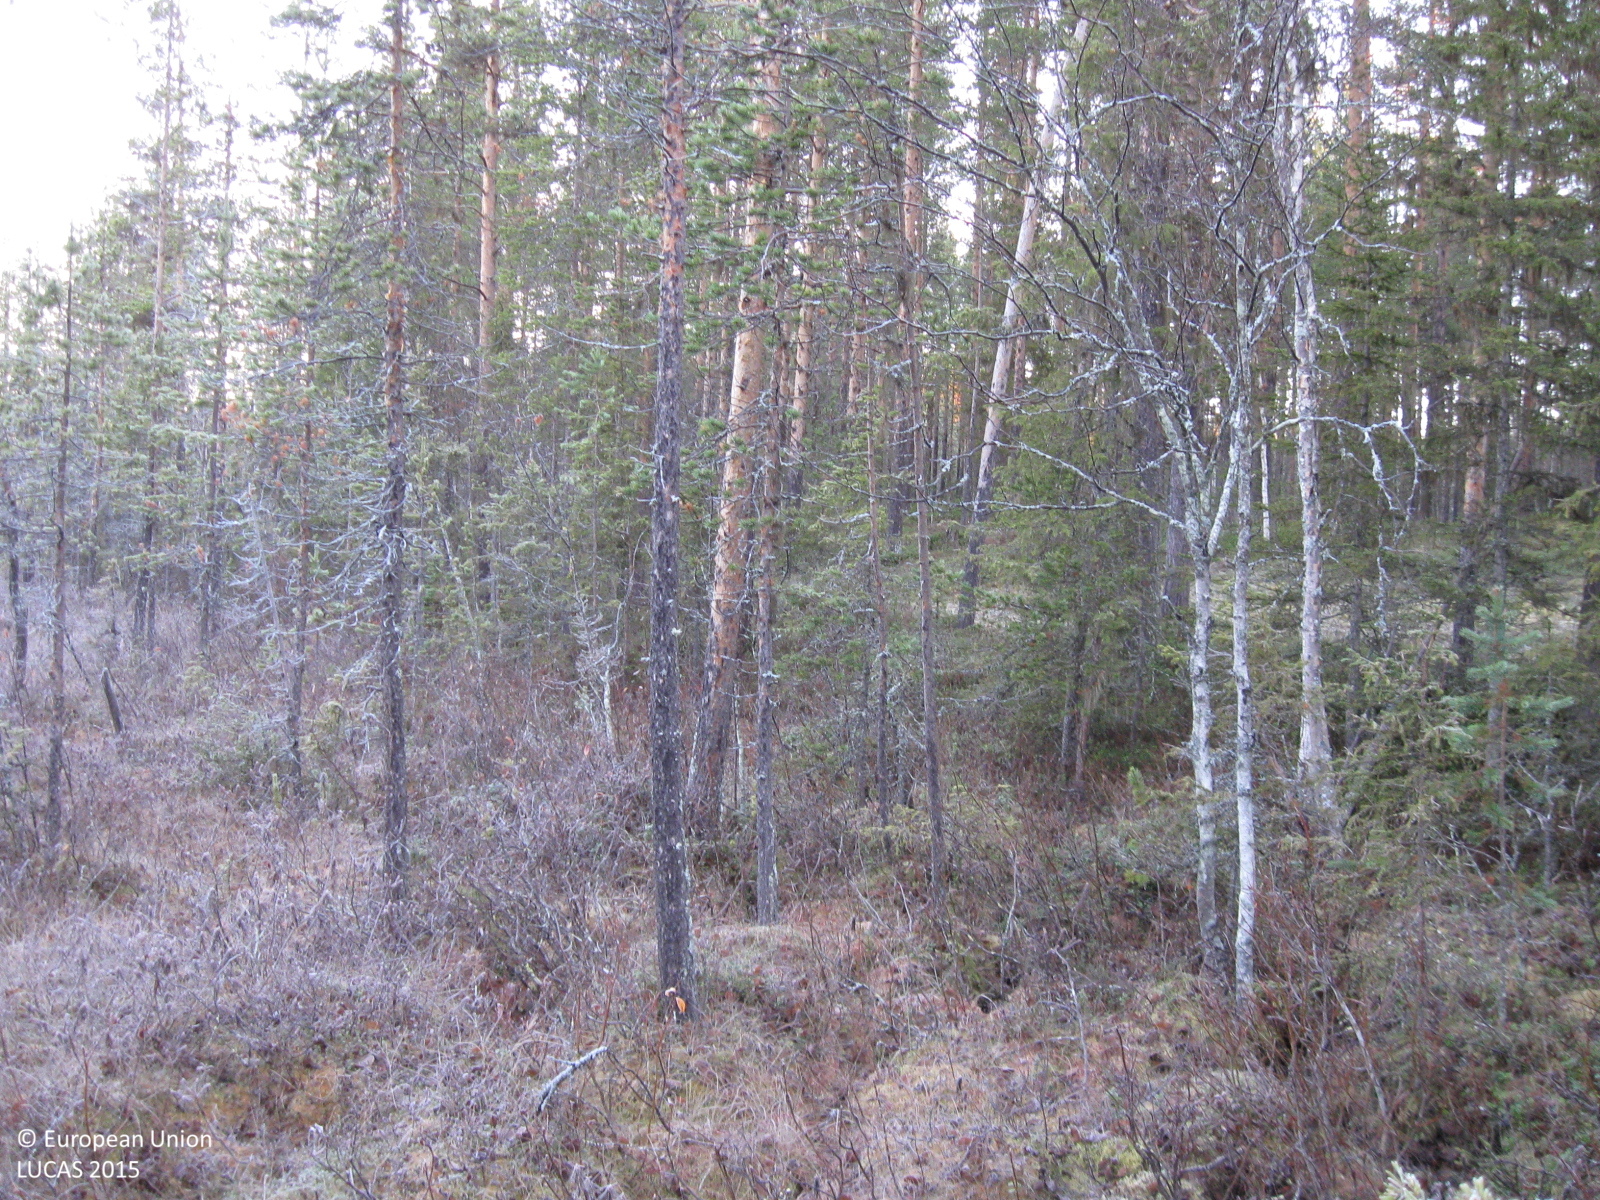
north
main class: Woodland
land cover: Pine dominated coniferous woodland
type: mire and swamp forests
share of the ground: 50 - 75 %
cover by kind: coniferous forest trees 60 %, broadleaved forest trees 10 %, shrubs 10 %, herbaceous plants 10 %, lichens and mosses 10 %
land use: Forestry
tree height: > 5 m
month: October
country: SE
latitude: 66.4697
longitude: 20.9354
